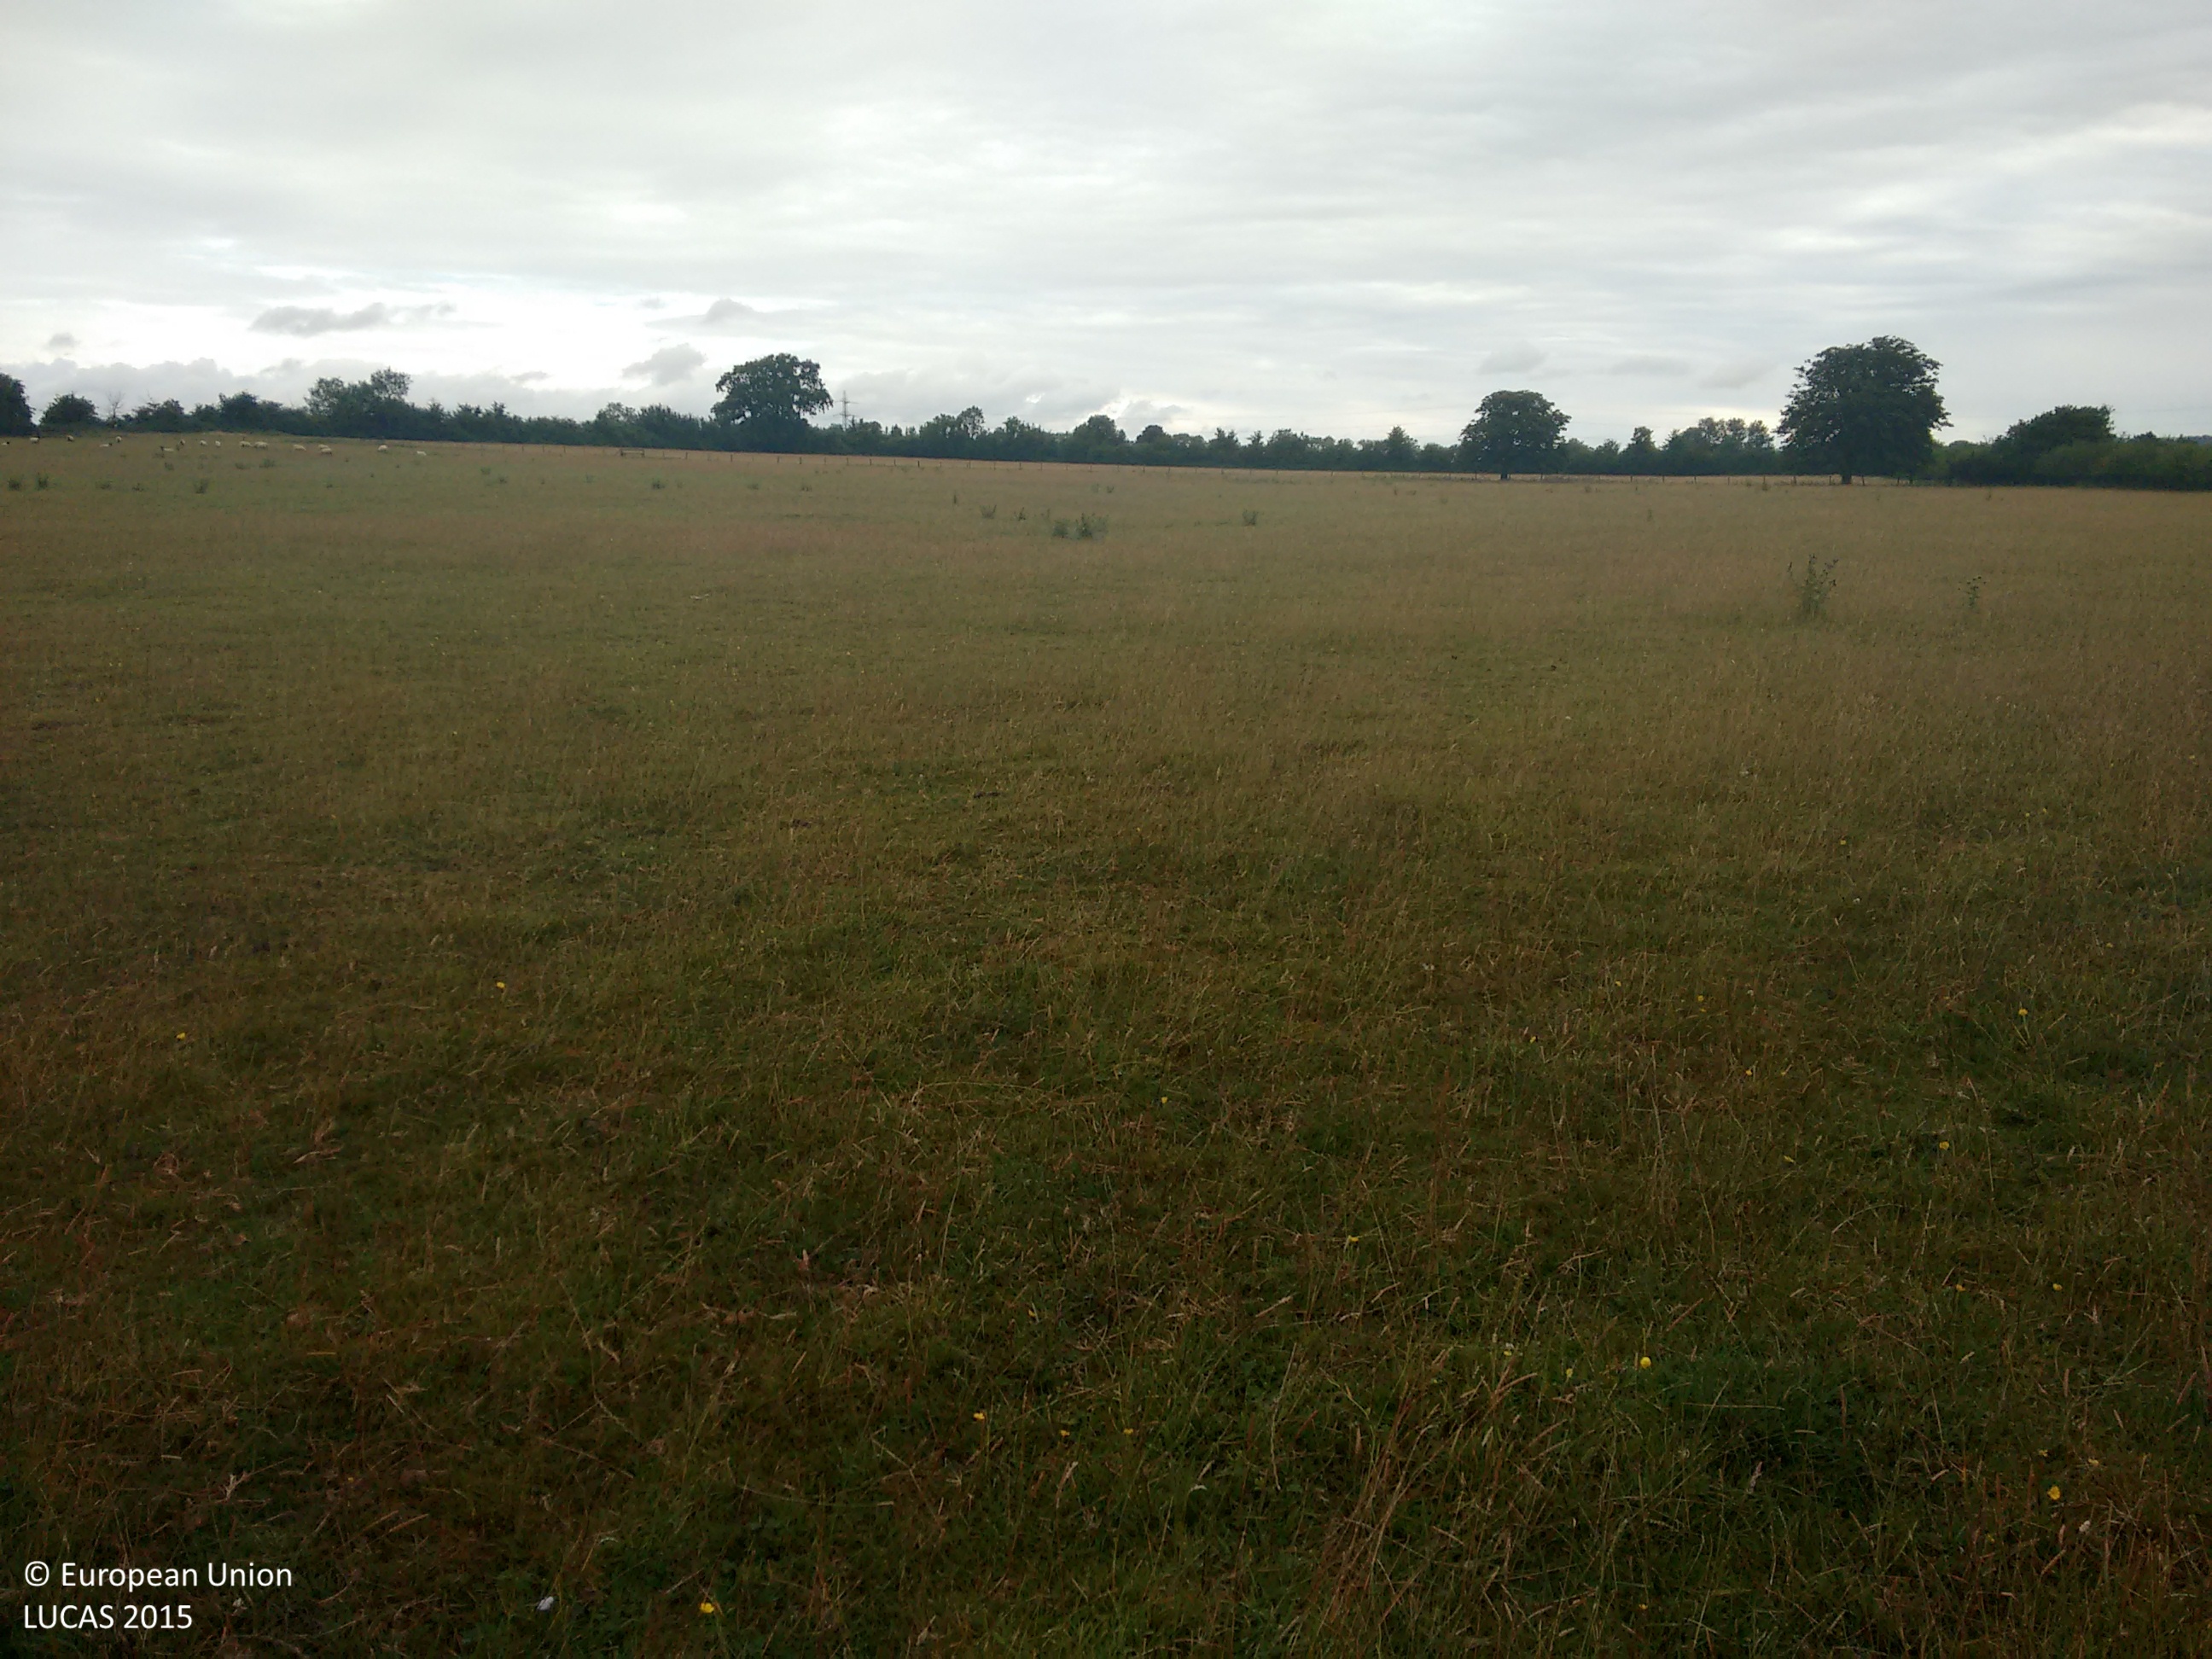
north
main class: Grassland
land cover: Grassland without tree/shrub cover
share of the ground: > 75 %
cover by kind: herbaceous plants 100 %
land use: Agriculture (excluding fallow land and kitchen gardens)
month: July
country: GB
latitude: 51.5460
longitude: -2.3646
